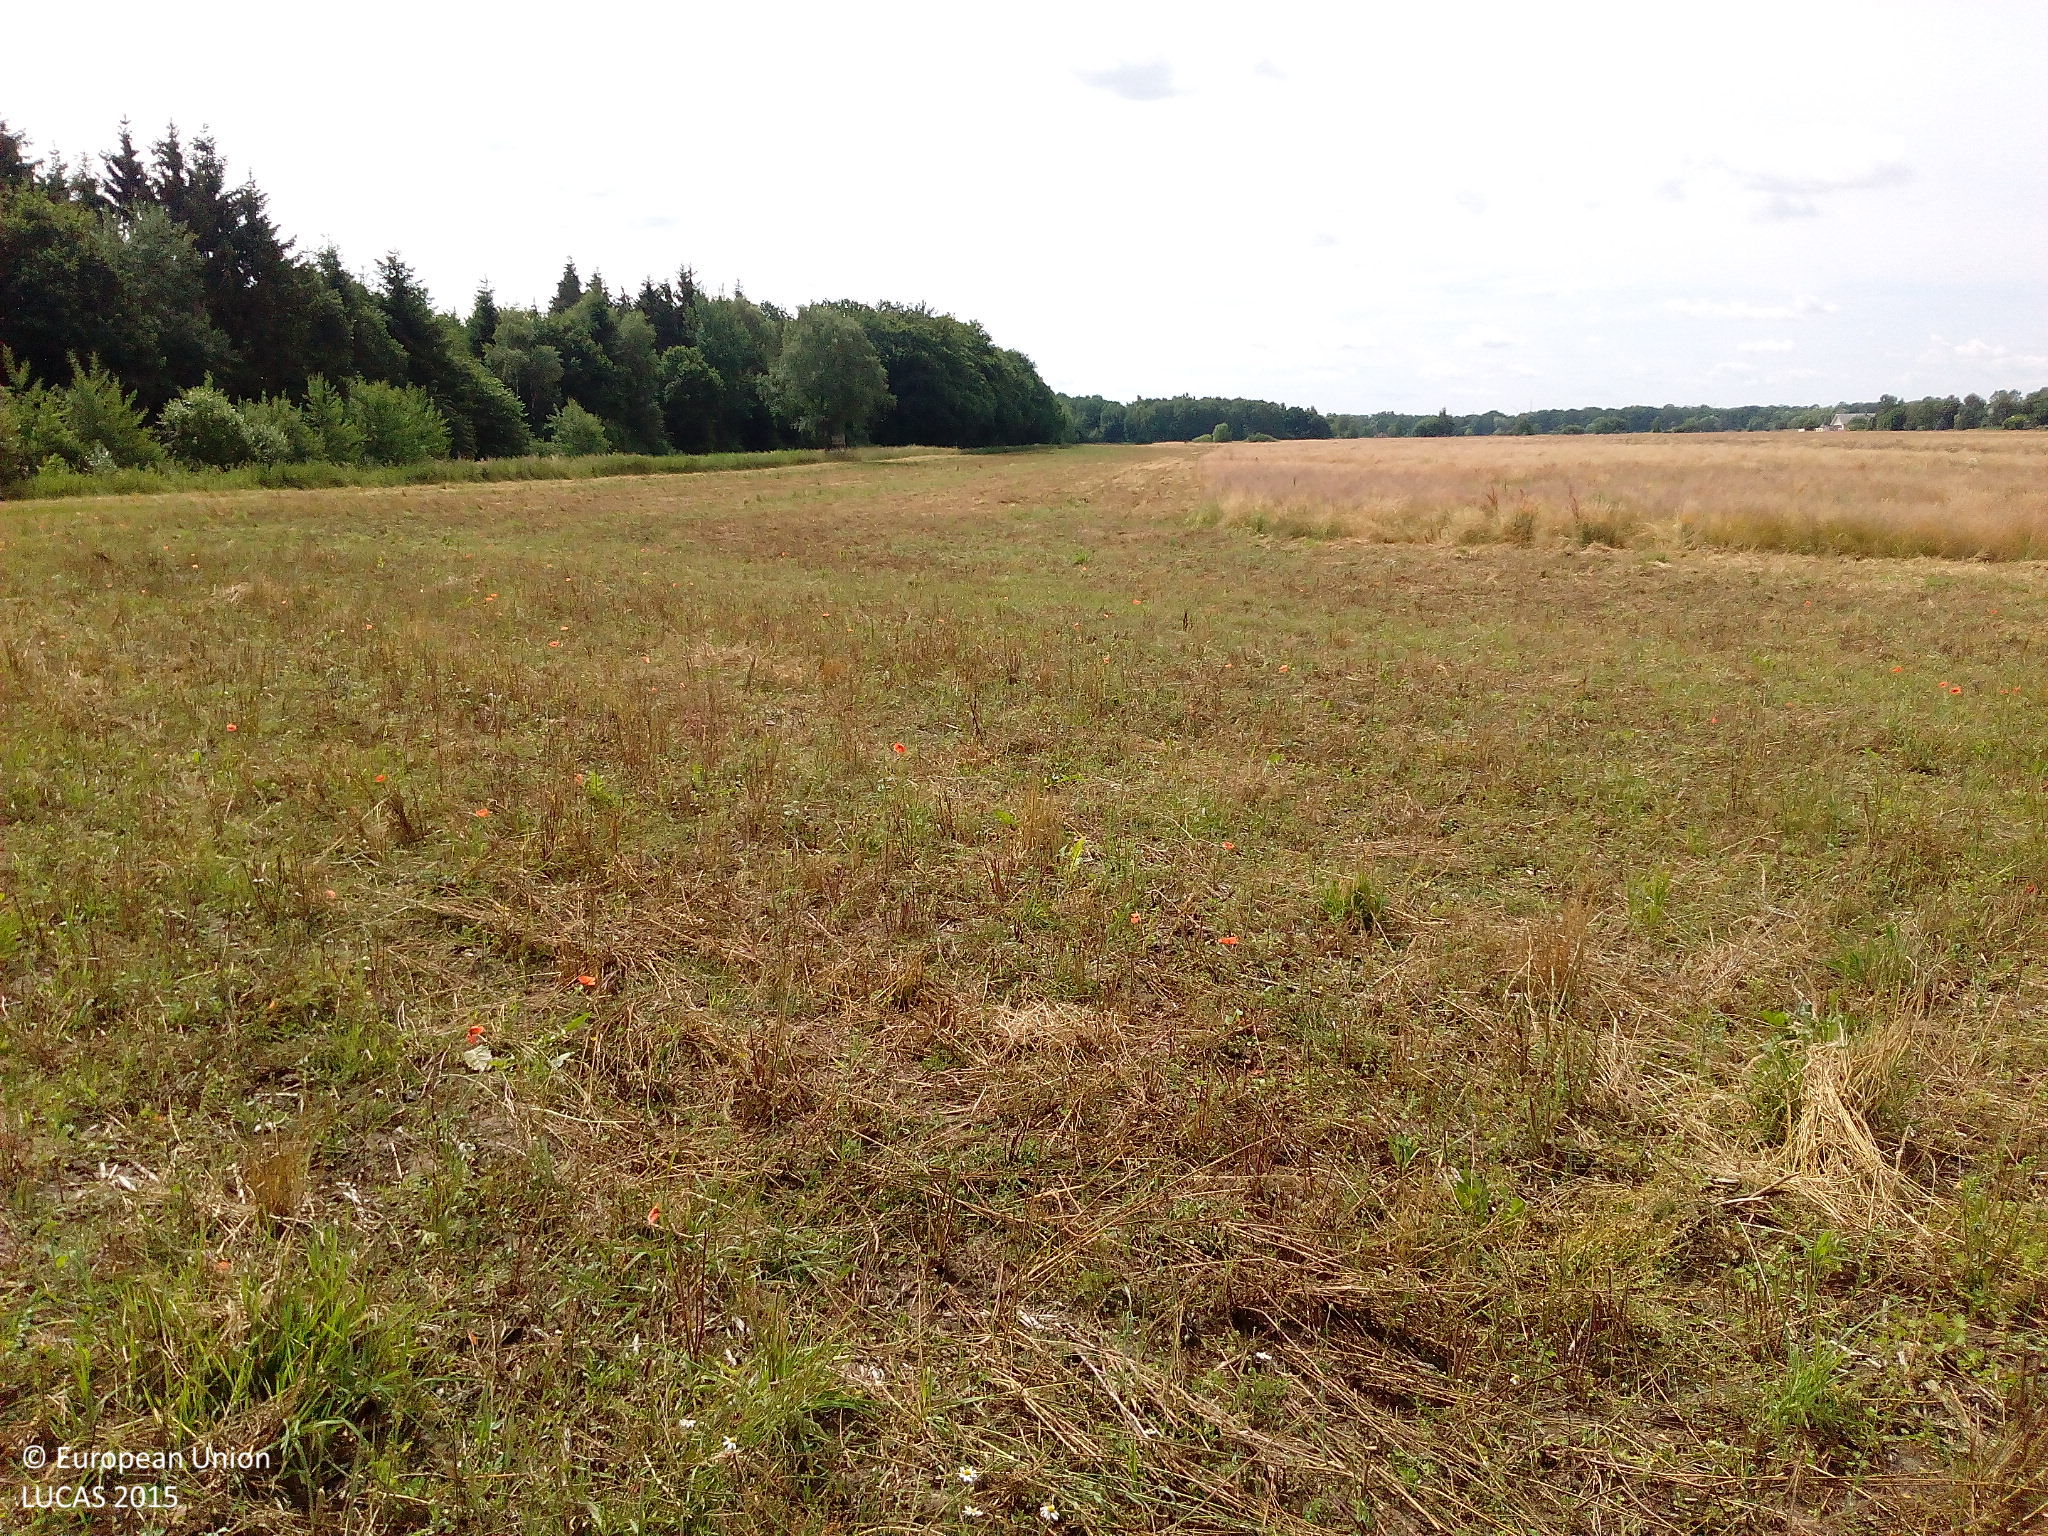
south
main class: Grassland
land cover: Spontaneously vegetated surfaces
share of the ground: > 75 %
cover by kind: herbaceous plants 100 %
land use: Agriculture (excluding fallow land and kitchen gardens)
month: July
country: DE
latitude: 54.1308
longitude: 13.2896
